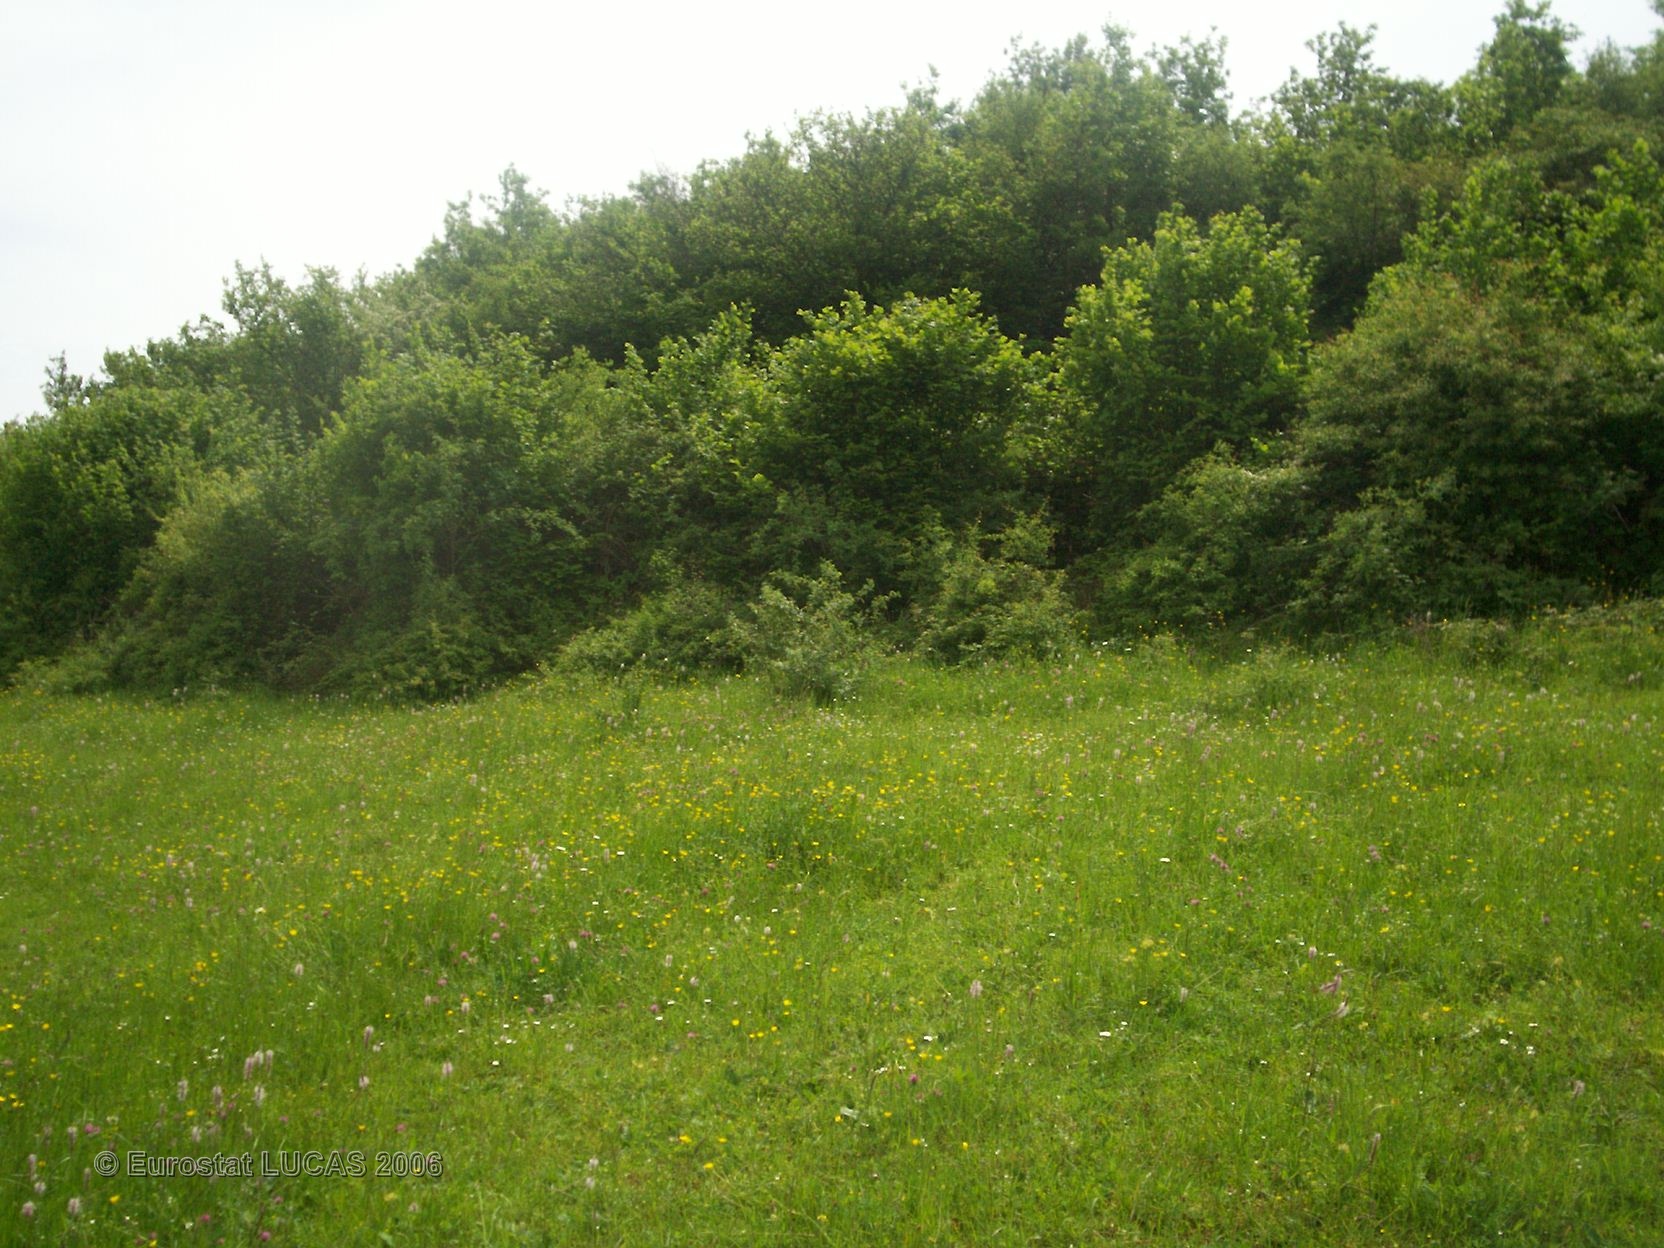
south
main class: Grassland
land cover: Grassland without tree/shrub cover
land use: Agriculture (excluding fallow land and kitchen gardens)
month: May
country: FR
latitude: 46.7240
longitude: 4.6759
